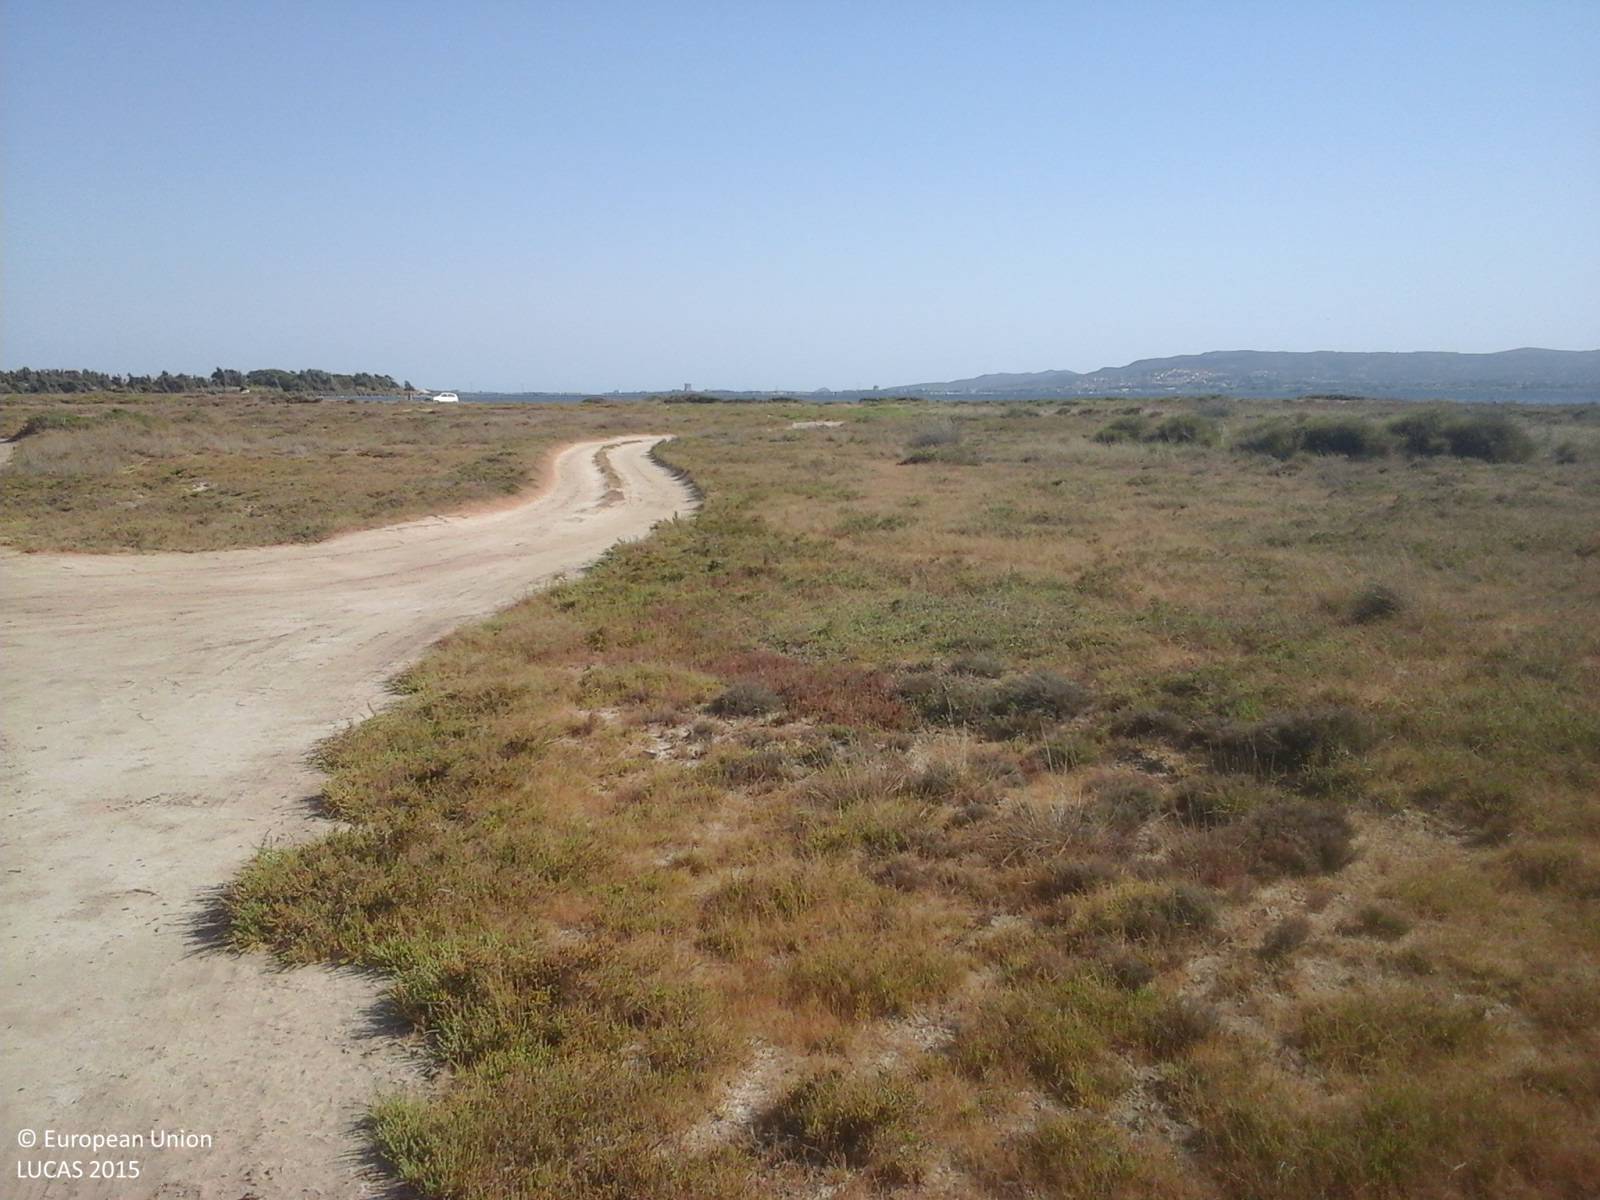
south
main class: Grassland
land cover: Grassland without tree/shrub cover
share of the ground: > 75 %
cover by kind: herbaceous plants 90 %, unconsolidated bare surface 10 %
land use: Semi-natural and natural areas not in use
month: July
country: IT
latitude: 39.1141
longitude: 8.4714
